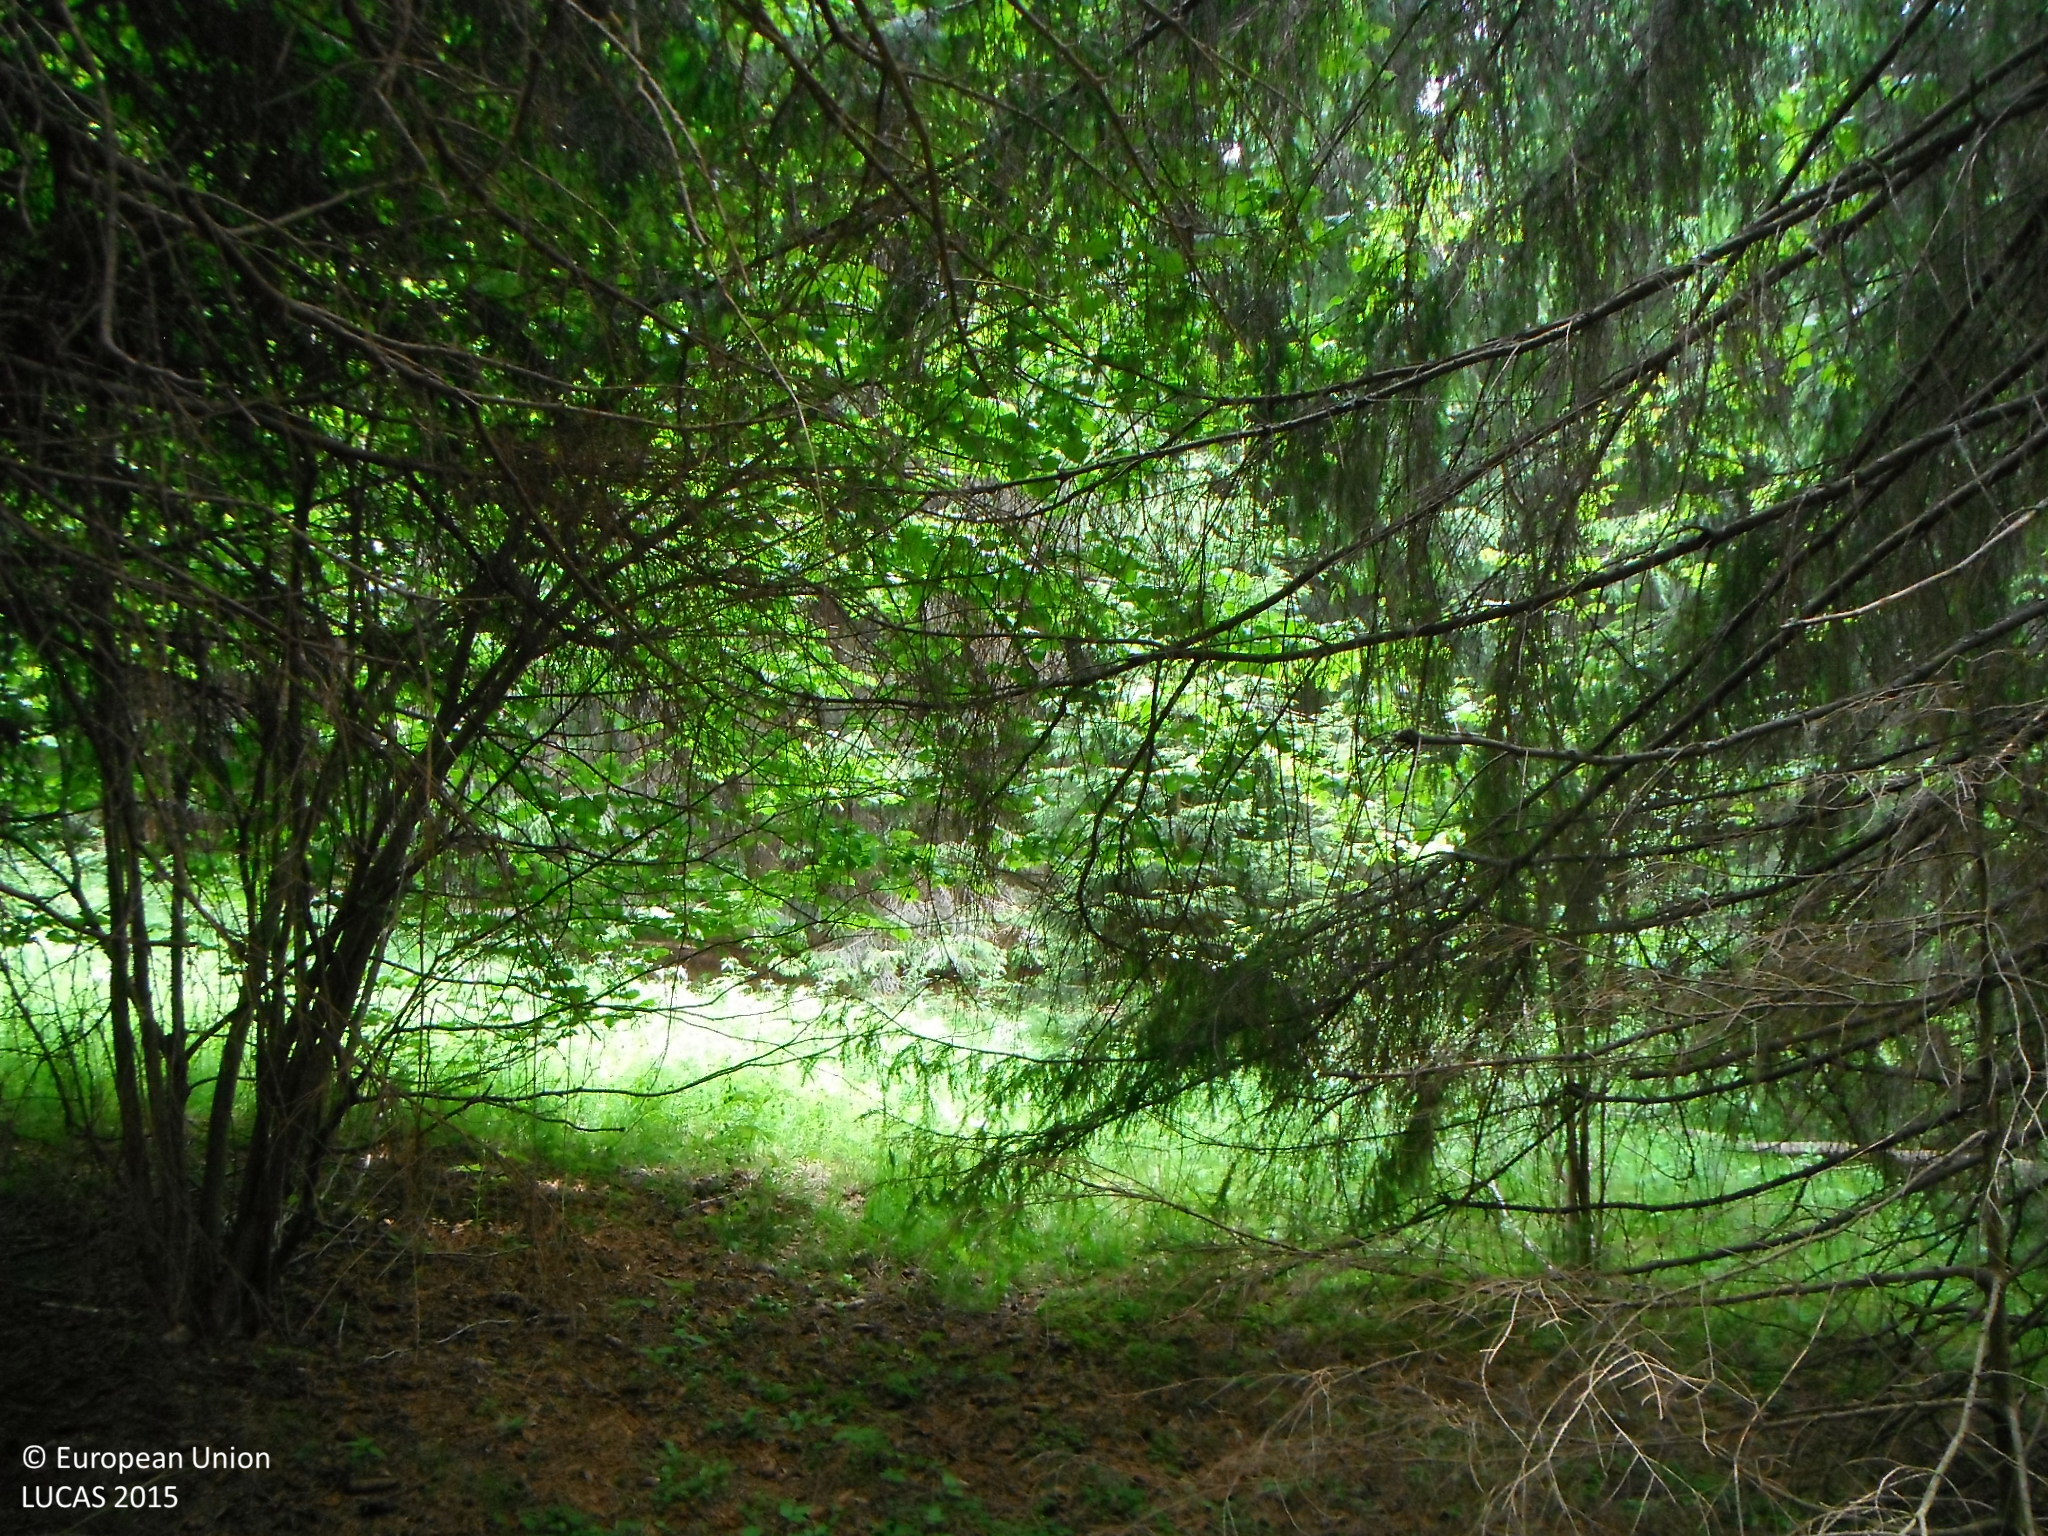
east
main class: Woodland
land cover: Spruce dominated coniferous woodland
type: alpine coniferous forest
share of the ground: > 75 %
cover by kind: coniferous forest trees 100 %
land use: Forestry
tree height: > 5 m
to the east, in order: Spruce dominated coniferous woodland; Rivers and streams; Spruce dominated coniferous woodland; Spontaneously vegetated surfaces; Spruce dominated coniferous woodland
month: June
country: SK
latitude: 49.1908
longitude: 19.4801
